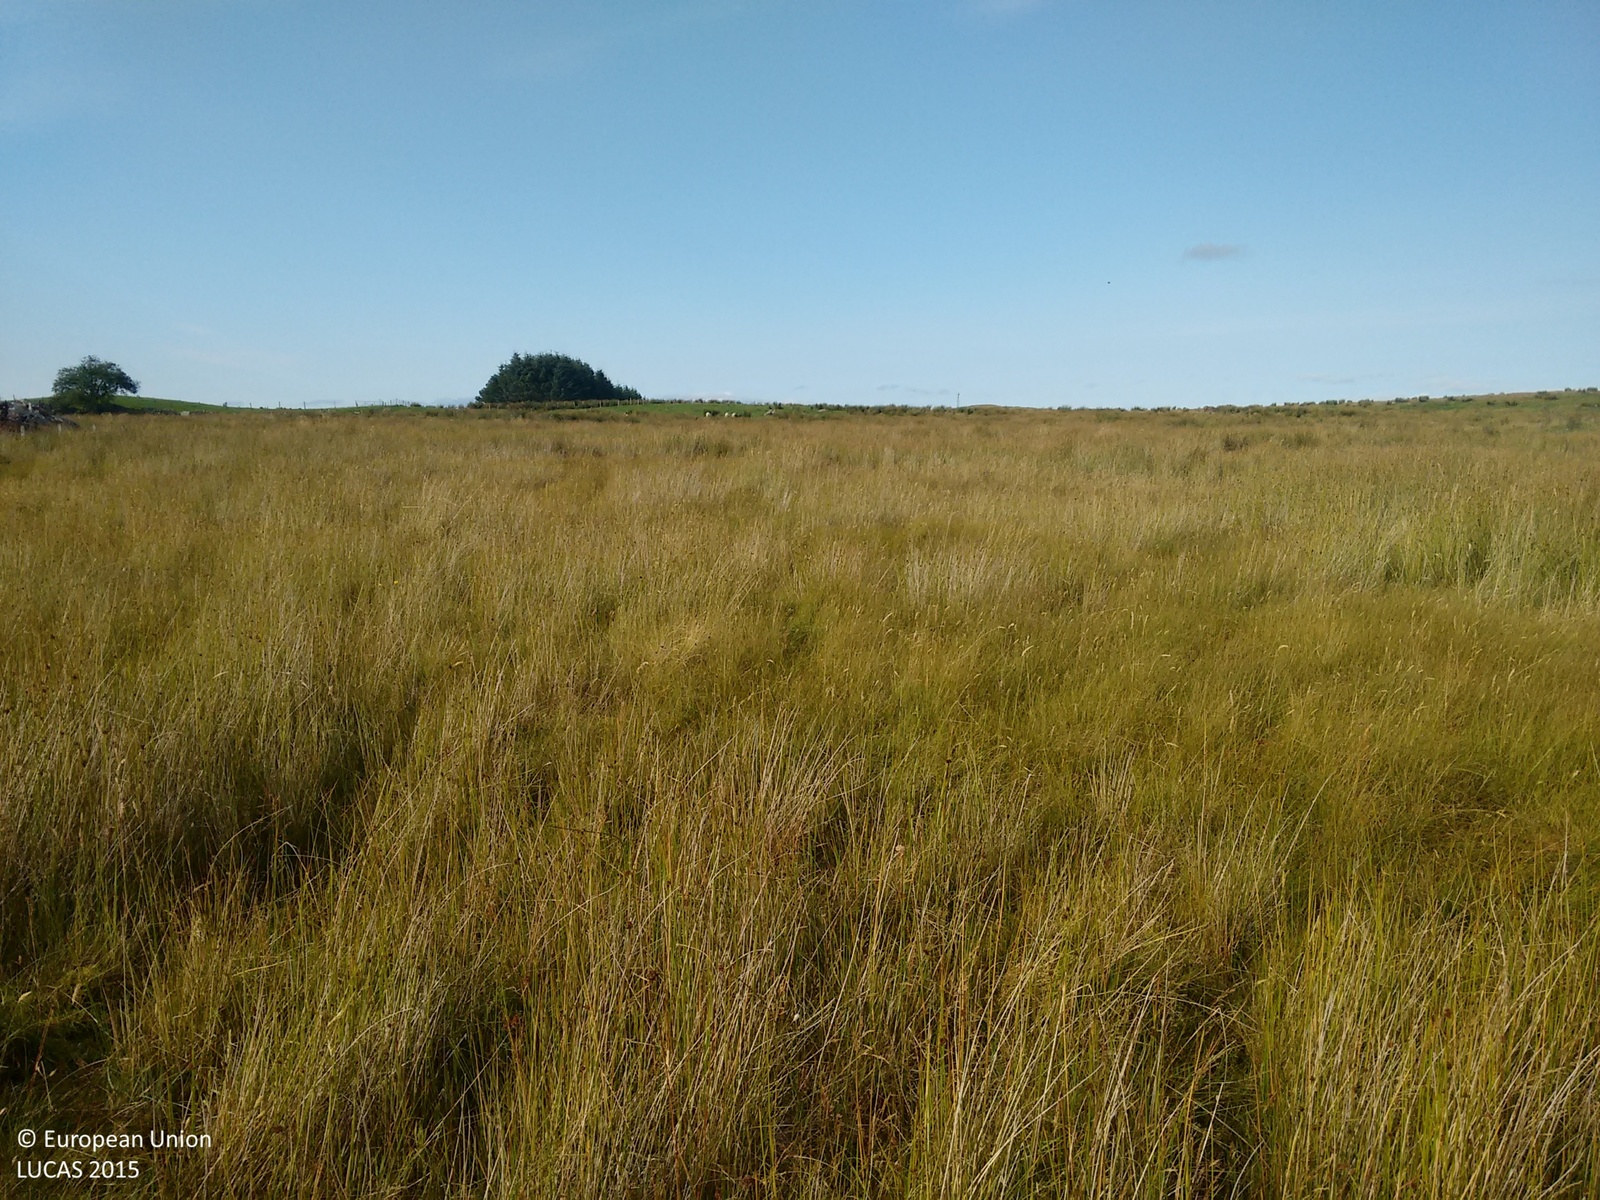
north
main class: Grassland
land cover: Grassland without tree/shrub cover
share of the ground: > 75 %
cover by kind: herbaceous plants 70 %, lichens and mosses 30 %
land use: Agriculture (excluding fallow land and kitchen gardens)
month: September
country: GB
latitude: 58.0041
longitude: -4.4186
